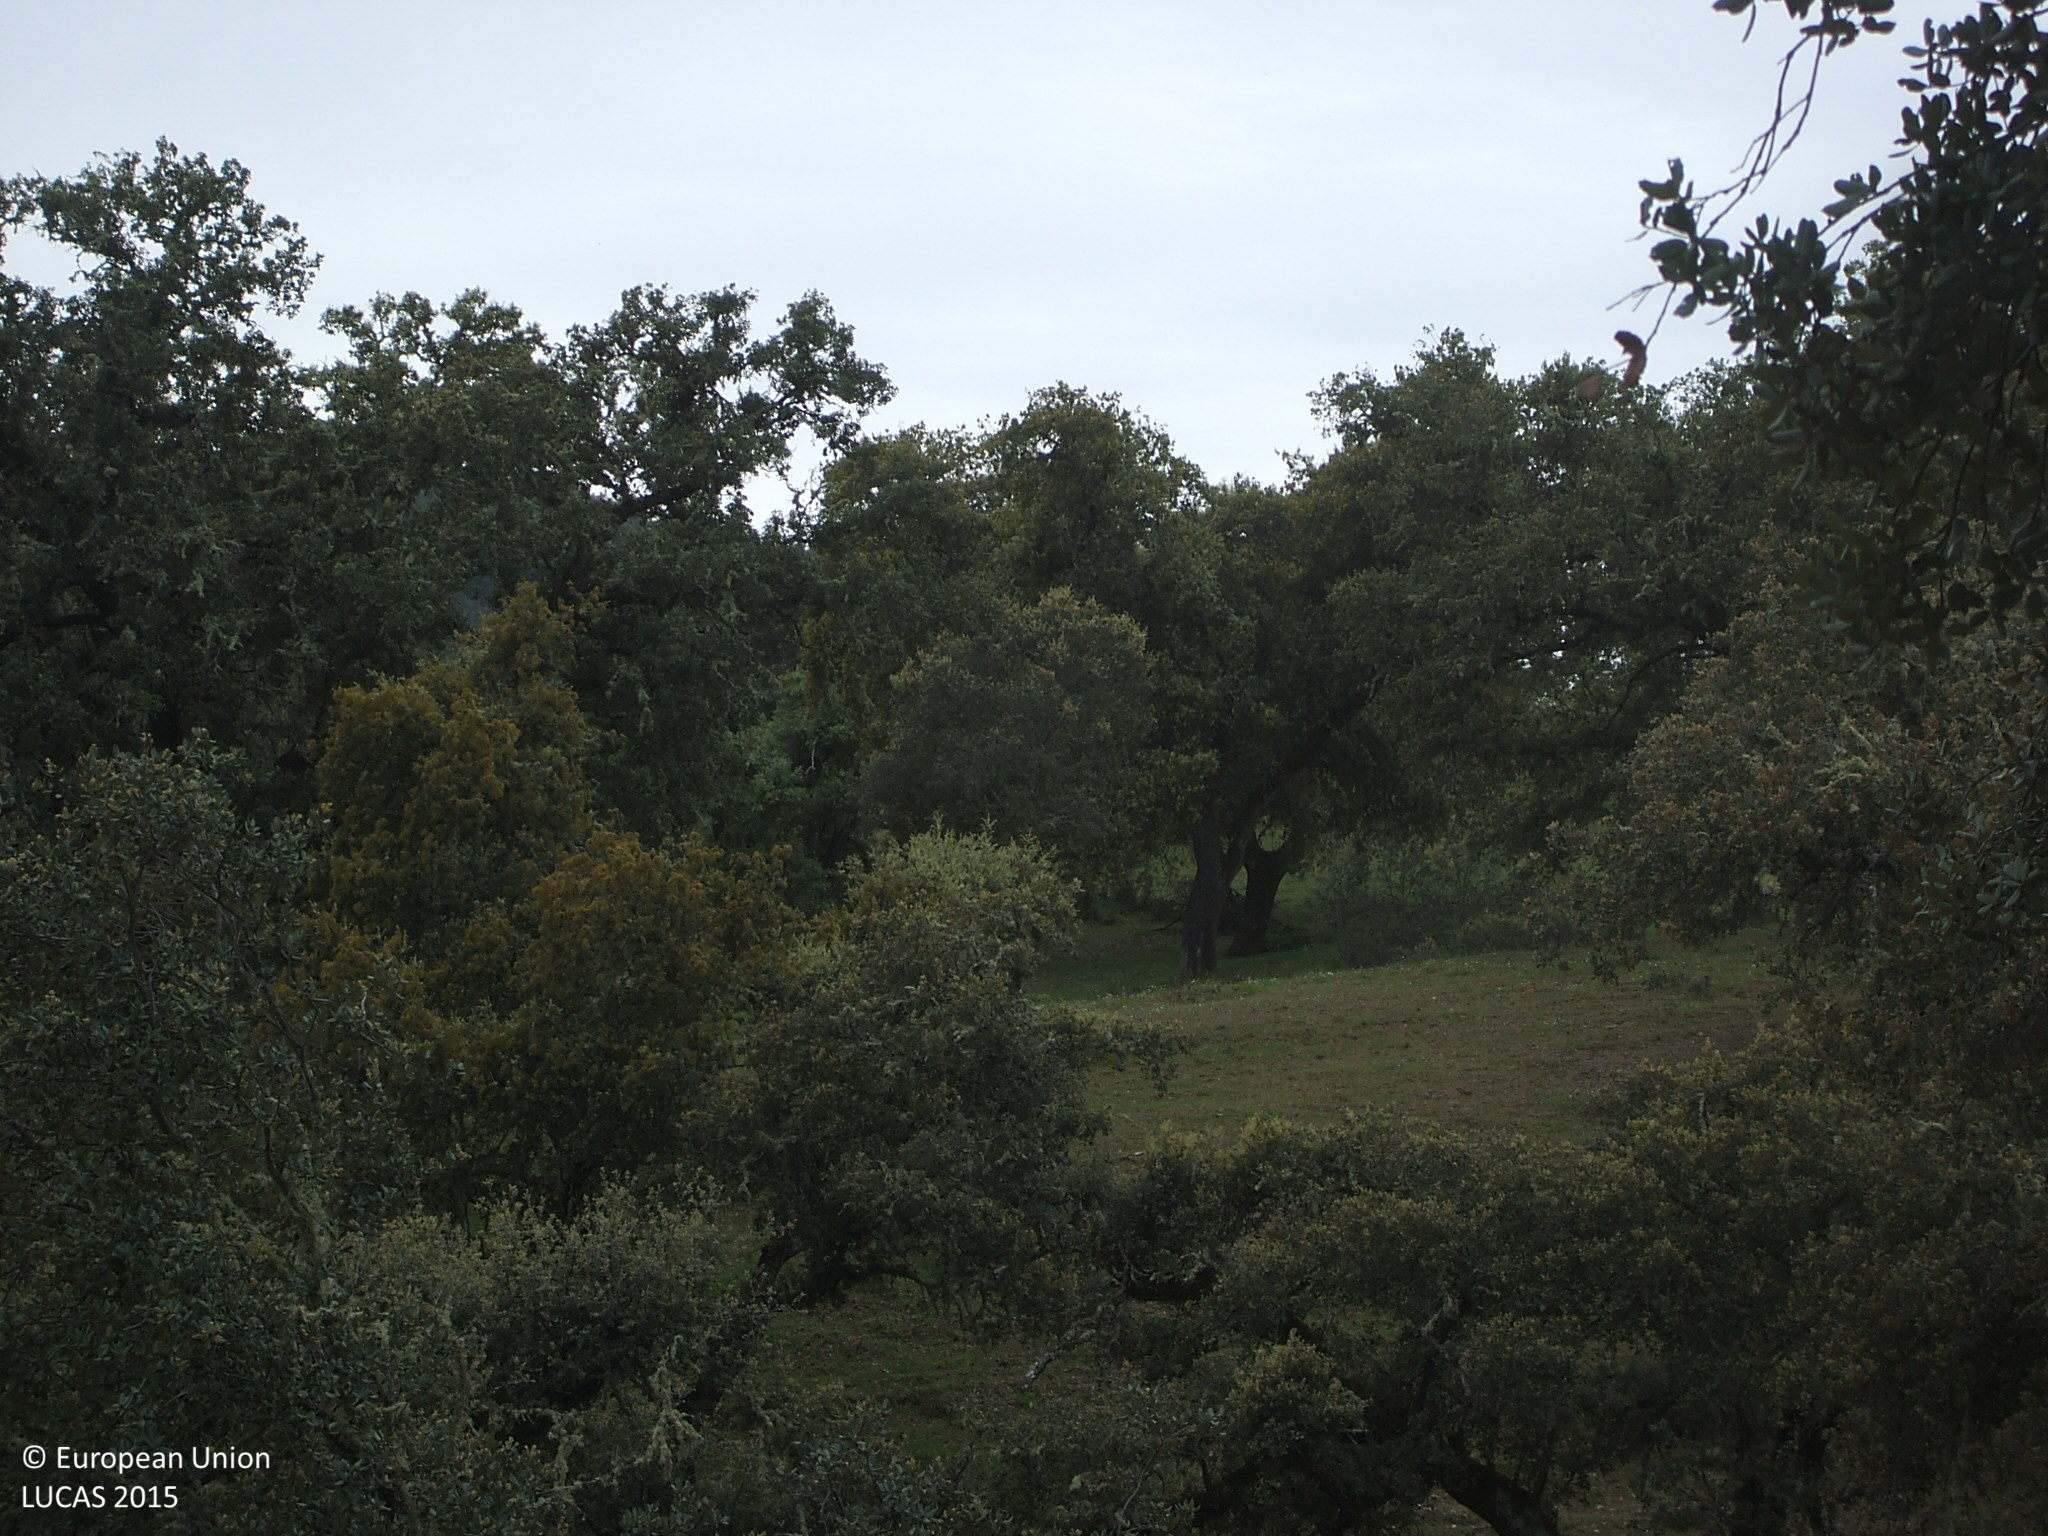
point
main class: Woodland
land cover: Broadleaved woodland
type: broadleaved evergreen forest
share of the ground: 25 - 50 %
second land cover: Grassland without tree/shrub cover
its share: > 75 %
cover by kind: herbaceous plants 60 %, broadleaved forest trees 40 %
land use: Forestry
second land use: Agriculture (excluding fallow land and kitchen gardens)
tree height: > 5 m
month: April
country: ES
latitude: 38.0630
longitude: -5.6568
